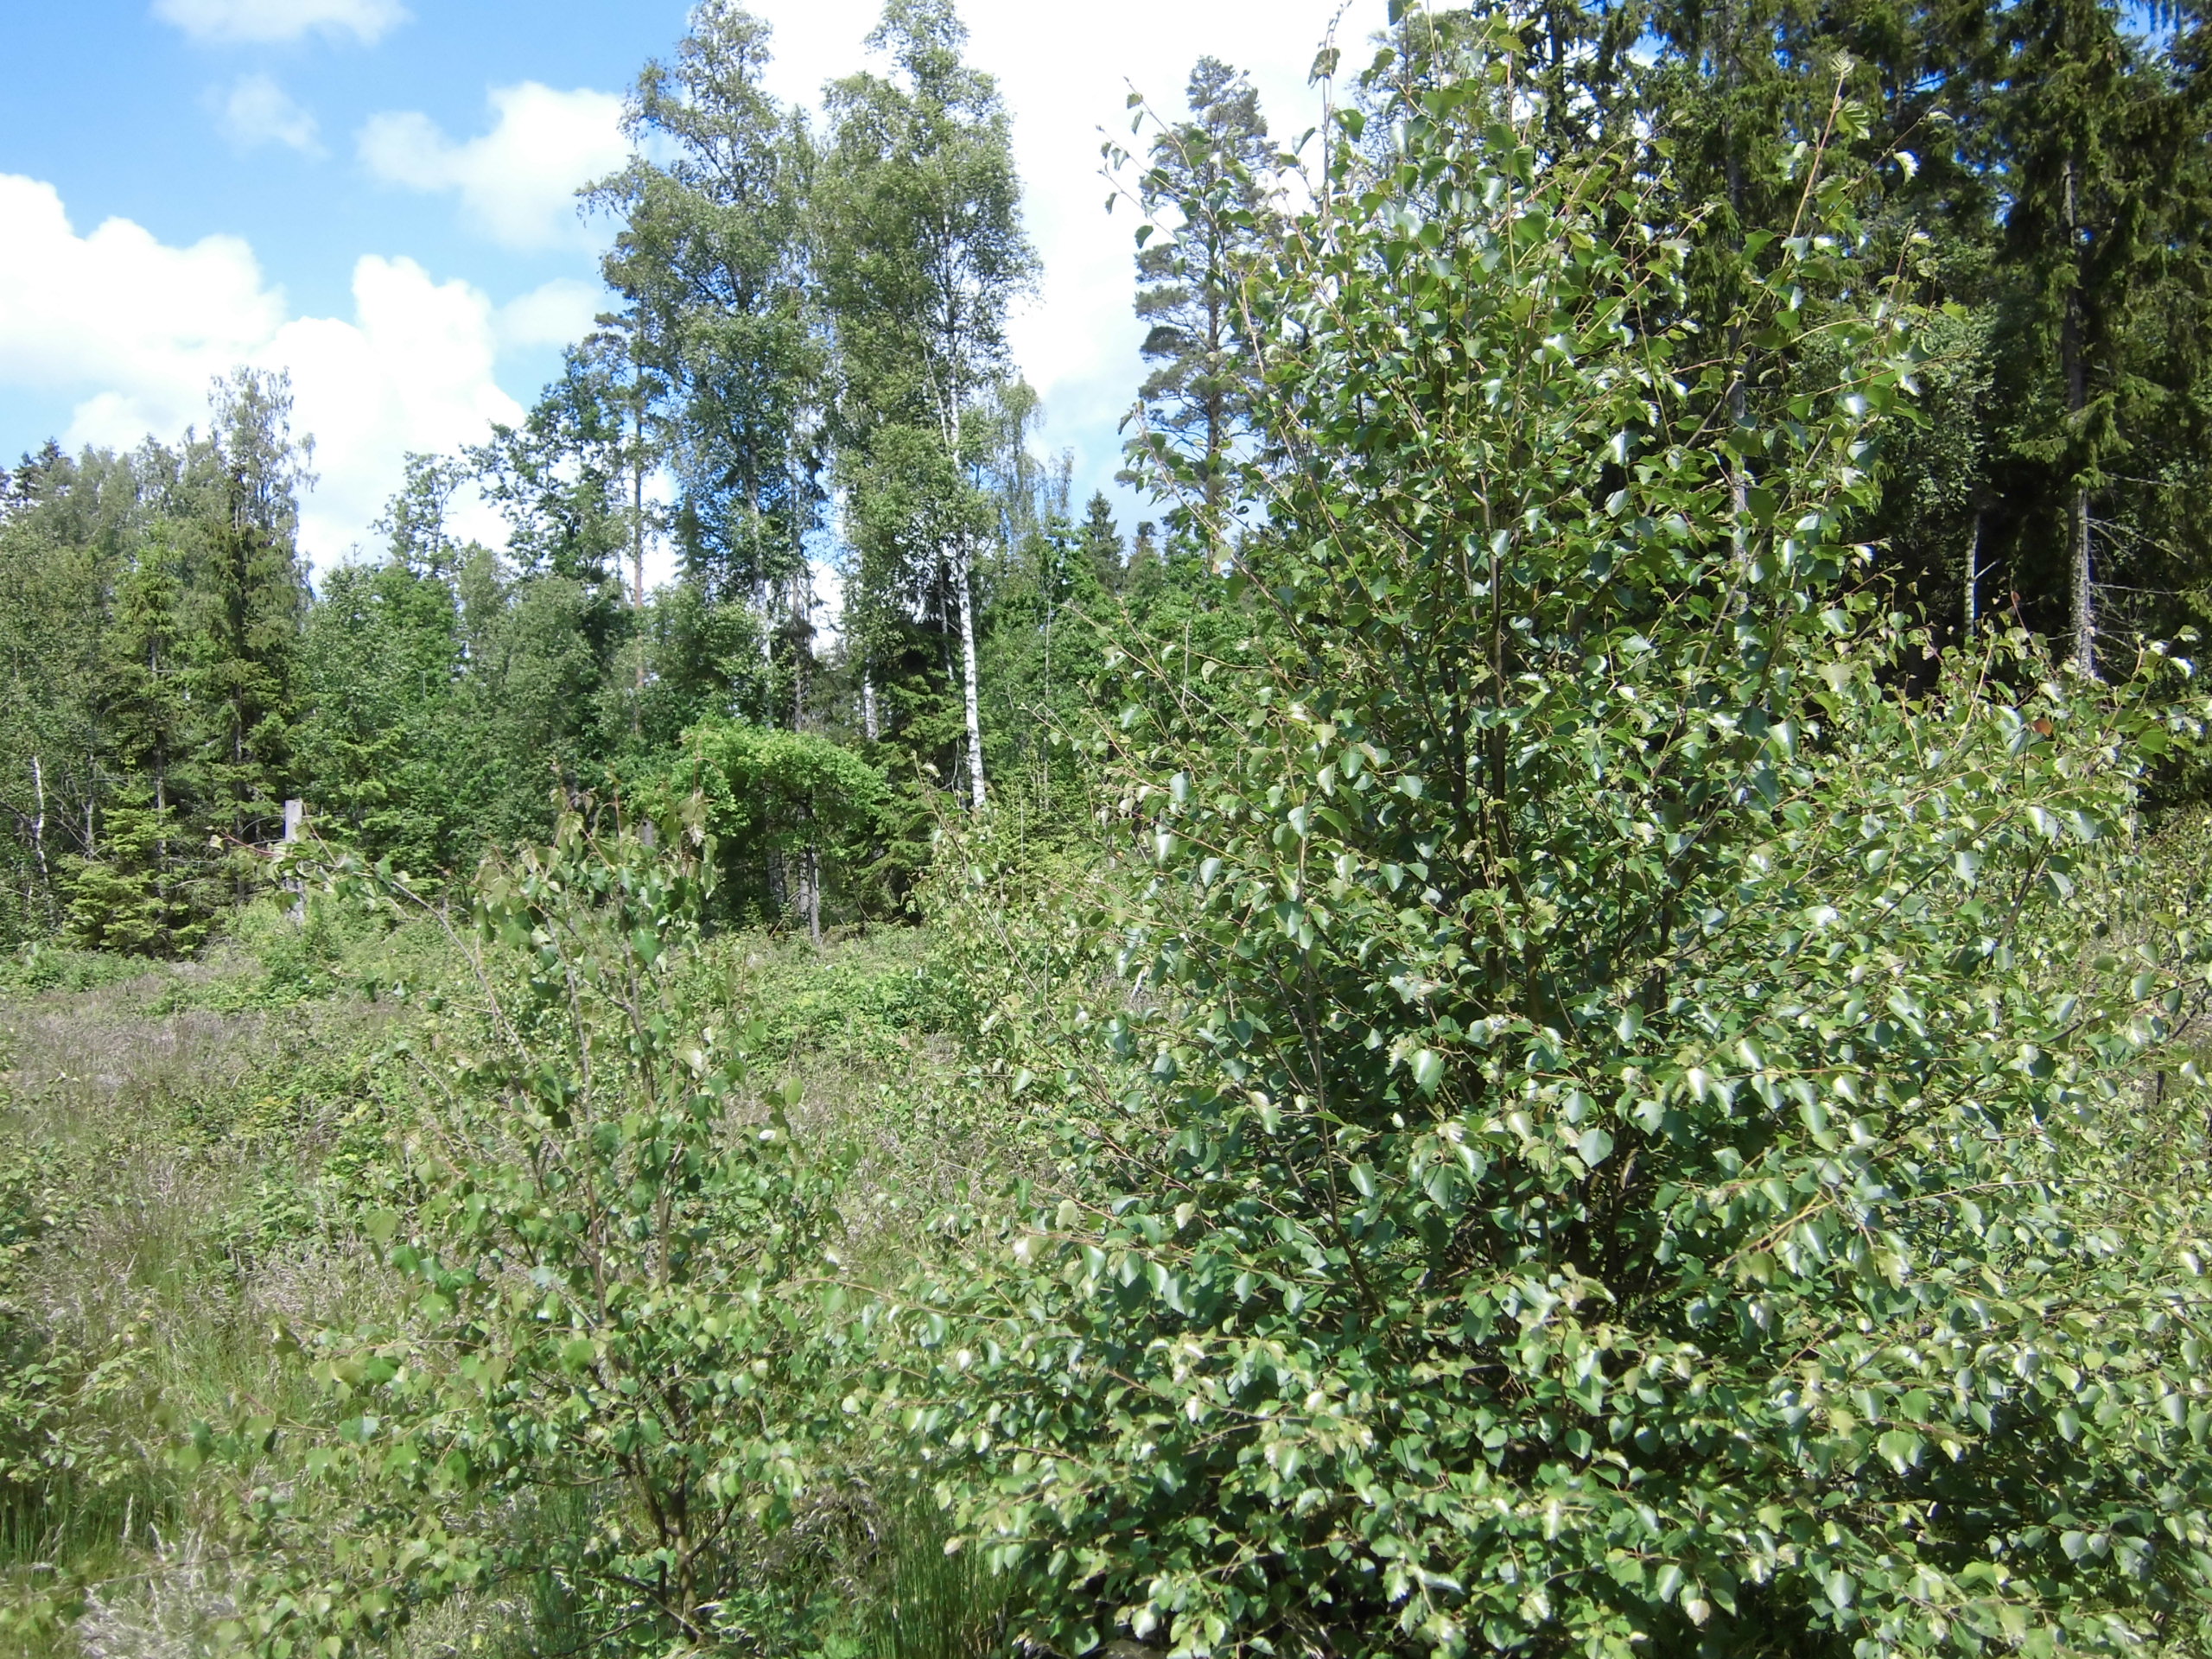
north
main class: Woodland
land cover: Broadleaved woodland
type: boreal forest
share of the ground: 50 - 75 %
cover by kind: broadleaved forest trees 50 %, herbaceous plants 20 %, shrubs 15 %, coniferous forest trees 5 %, lichens and mosses 5 %, unconsolidated bare surface 5 %
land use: Forestry
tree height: < 5 m
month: June
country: SE
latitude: 57.0362
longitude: 14.7591
